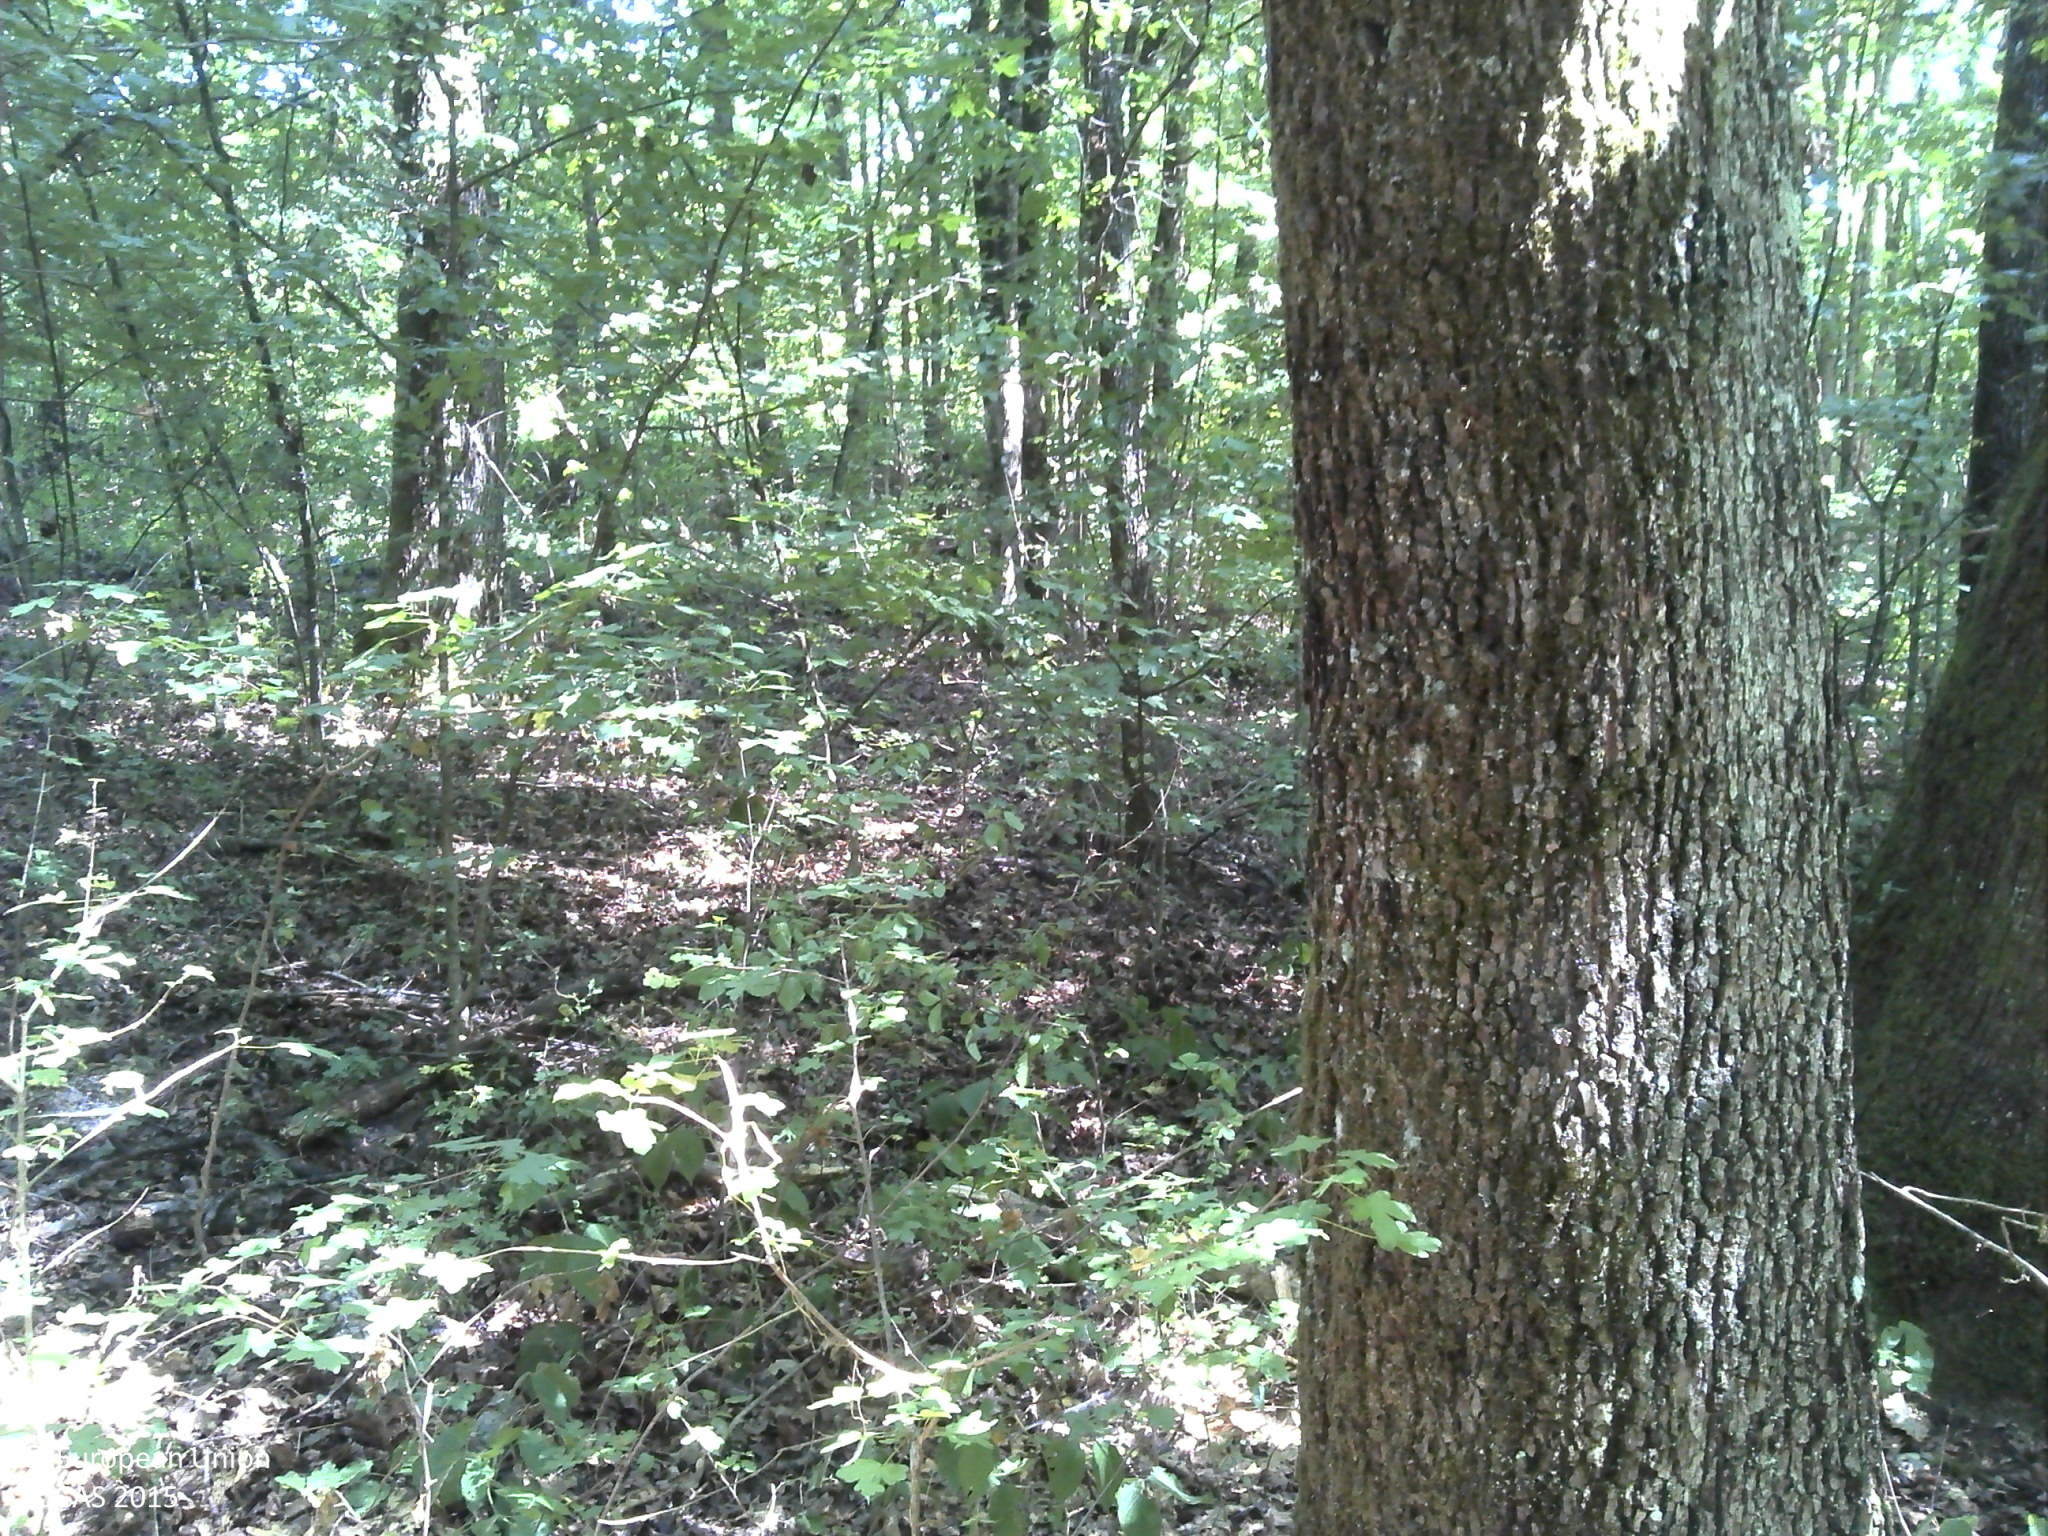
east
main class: Woodland
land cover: Broadleaved woodland
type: acidophilous oak and oak-birch forest
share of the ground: > 75 %
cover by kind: broadleaved forest trees 100 %
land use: Forestry
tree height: > 5 m
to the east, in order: Broadleaved woodland; Tracks; Broadleaved woodland; Shrubland with sparse tree cover; Other fruit trees and berries
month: August
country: HR
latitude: 45.3601
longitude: 16.4701
